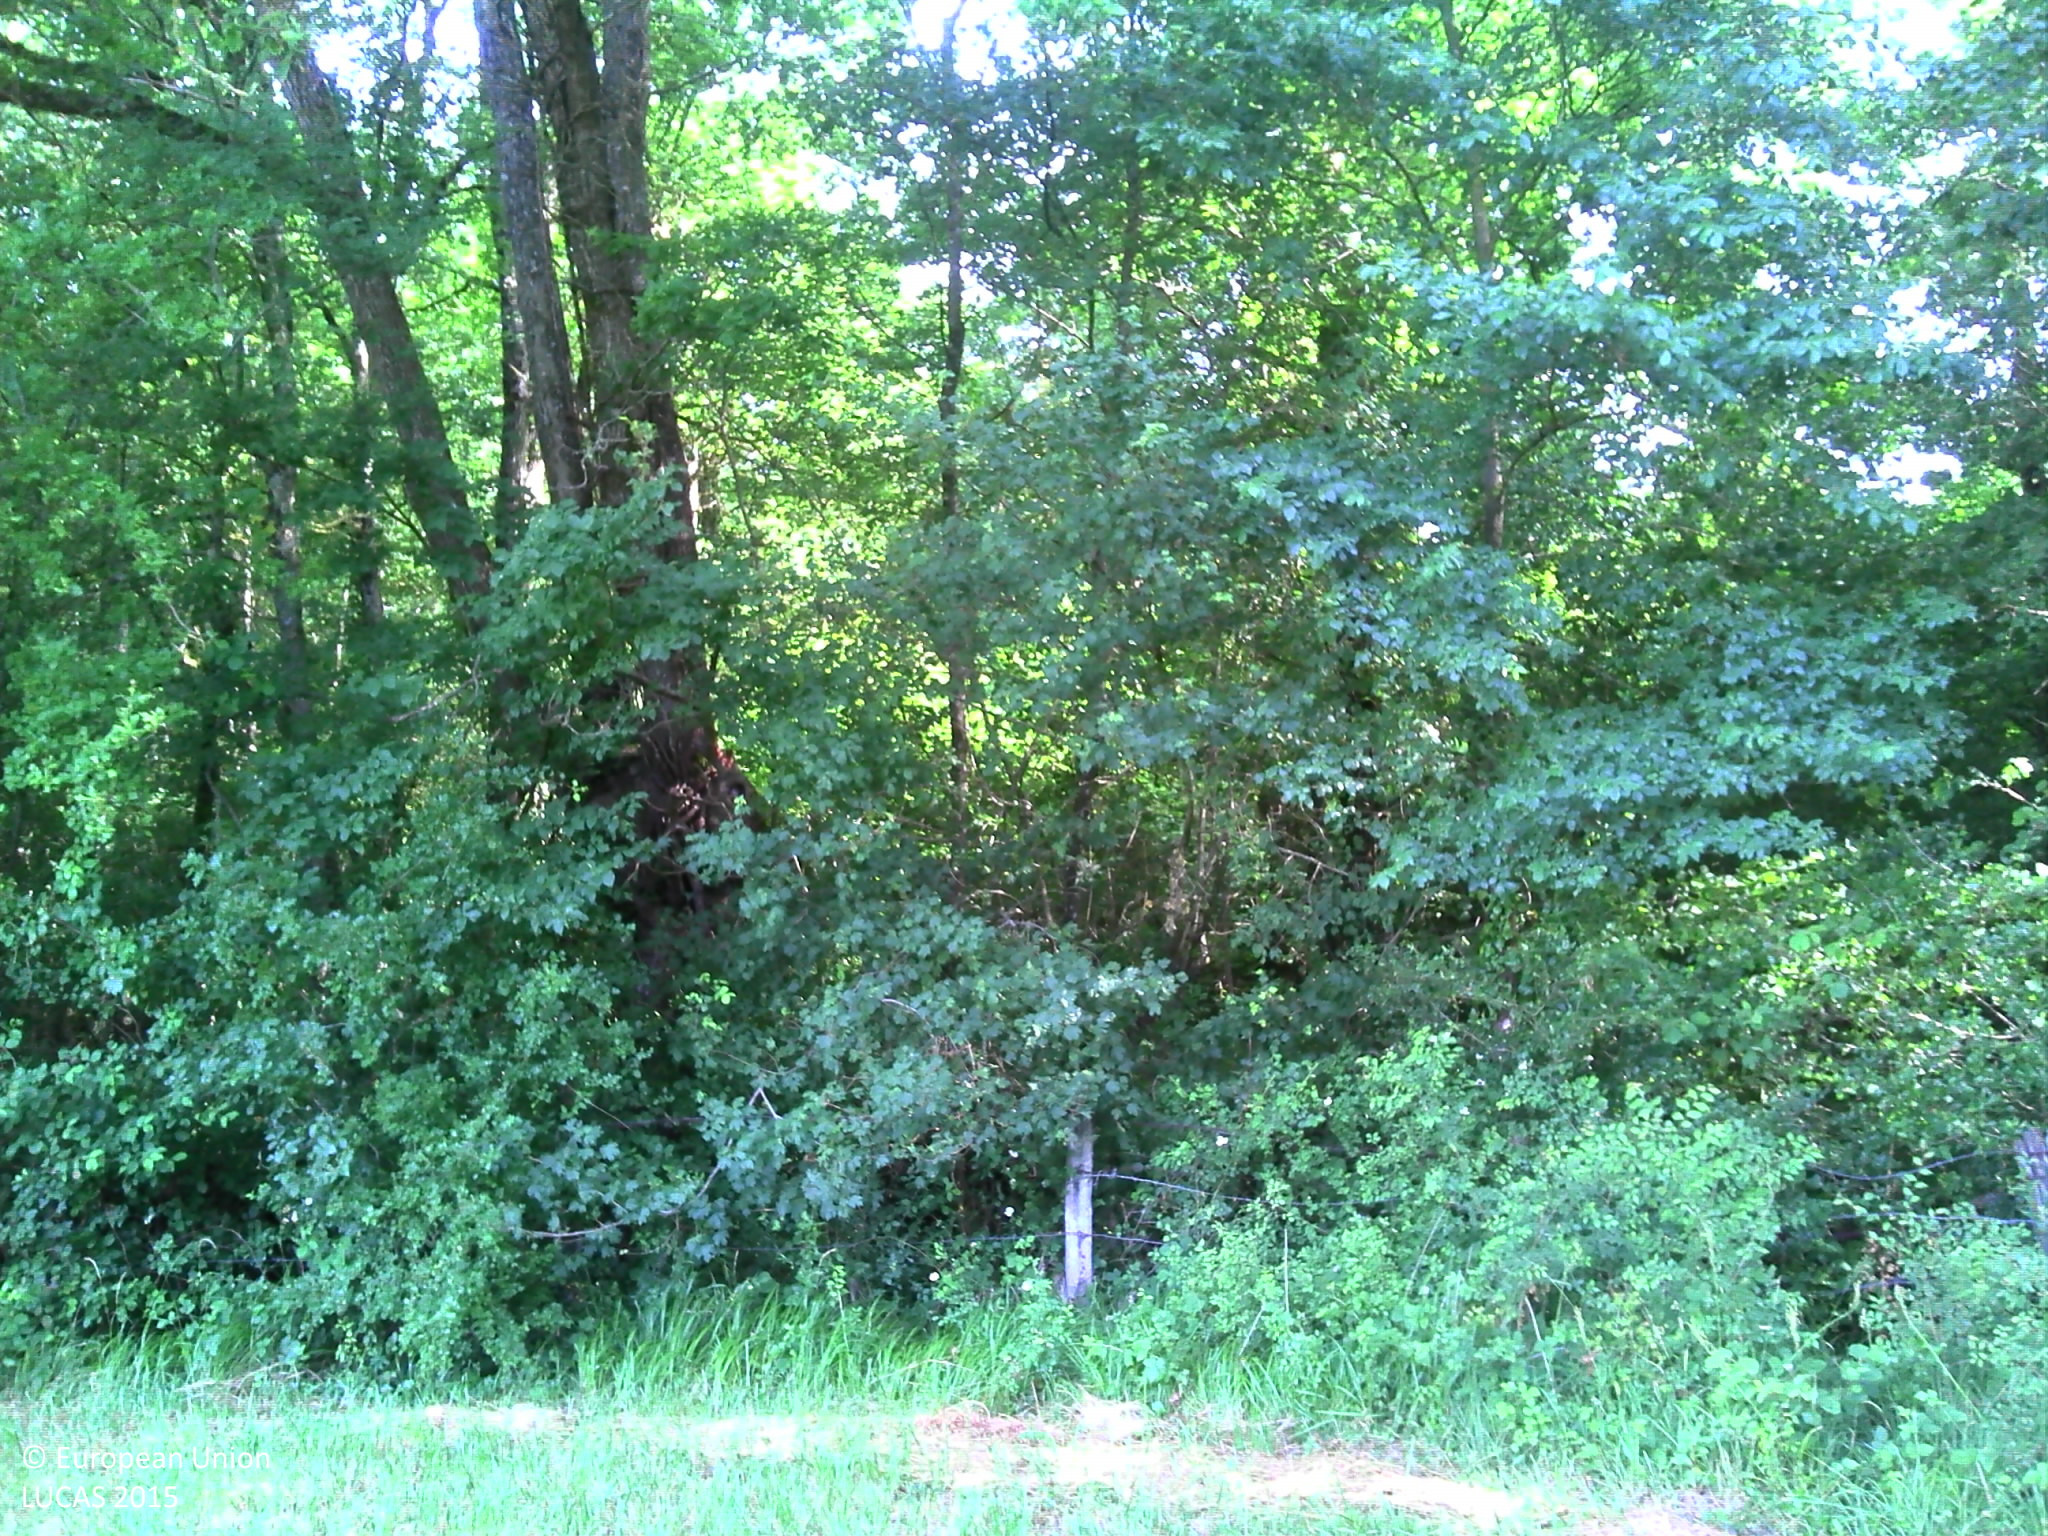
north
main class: Woodland
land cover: Broadleaved woodland
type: mesophytic deciduous forest
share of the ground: > 75 %
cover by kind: broadleaved forest trees 75 %, herbaceous plants 15 %, shrubs 10 %
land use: Forestry
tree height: > 5 m
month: June
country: FR
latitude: 48.3955
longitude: 0.1261
